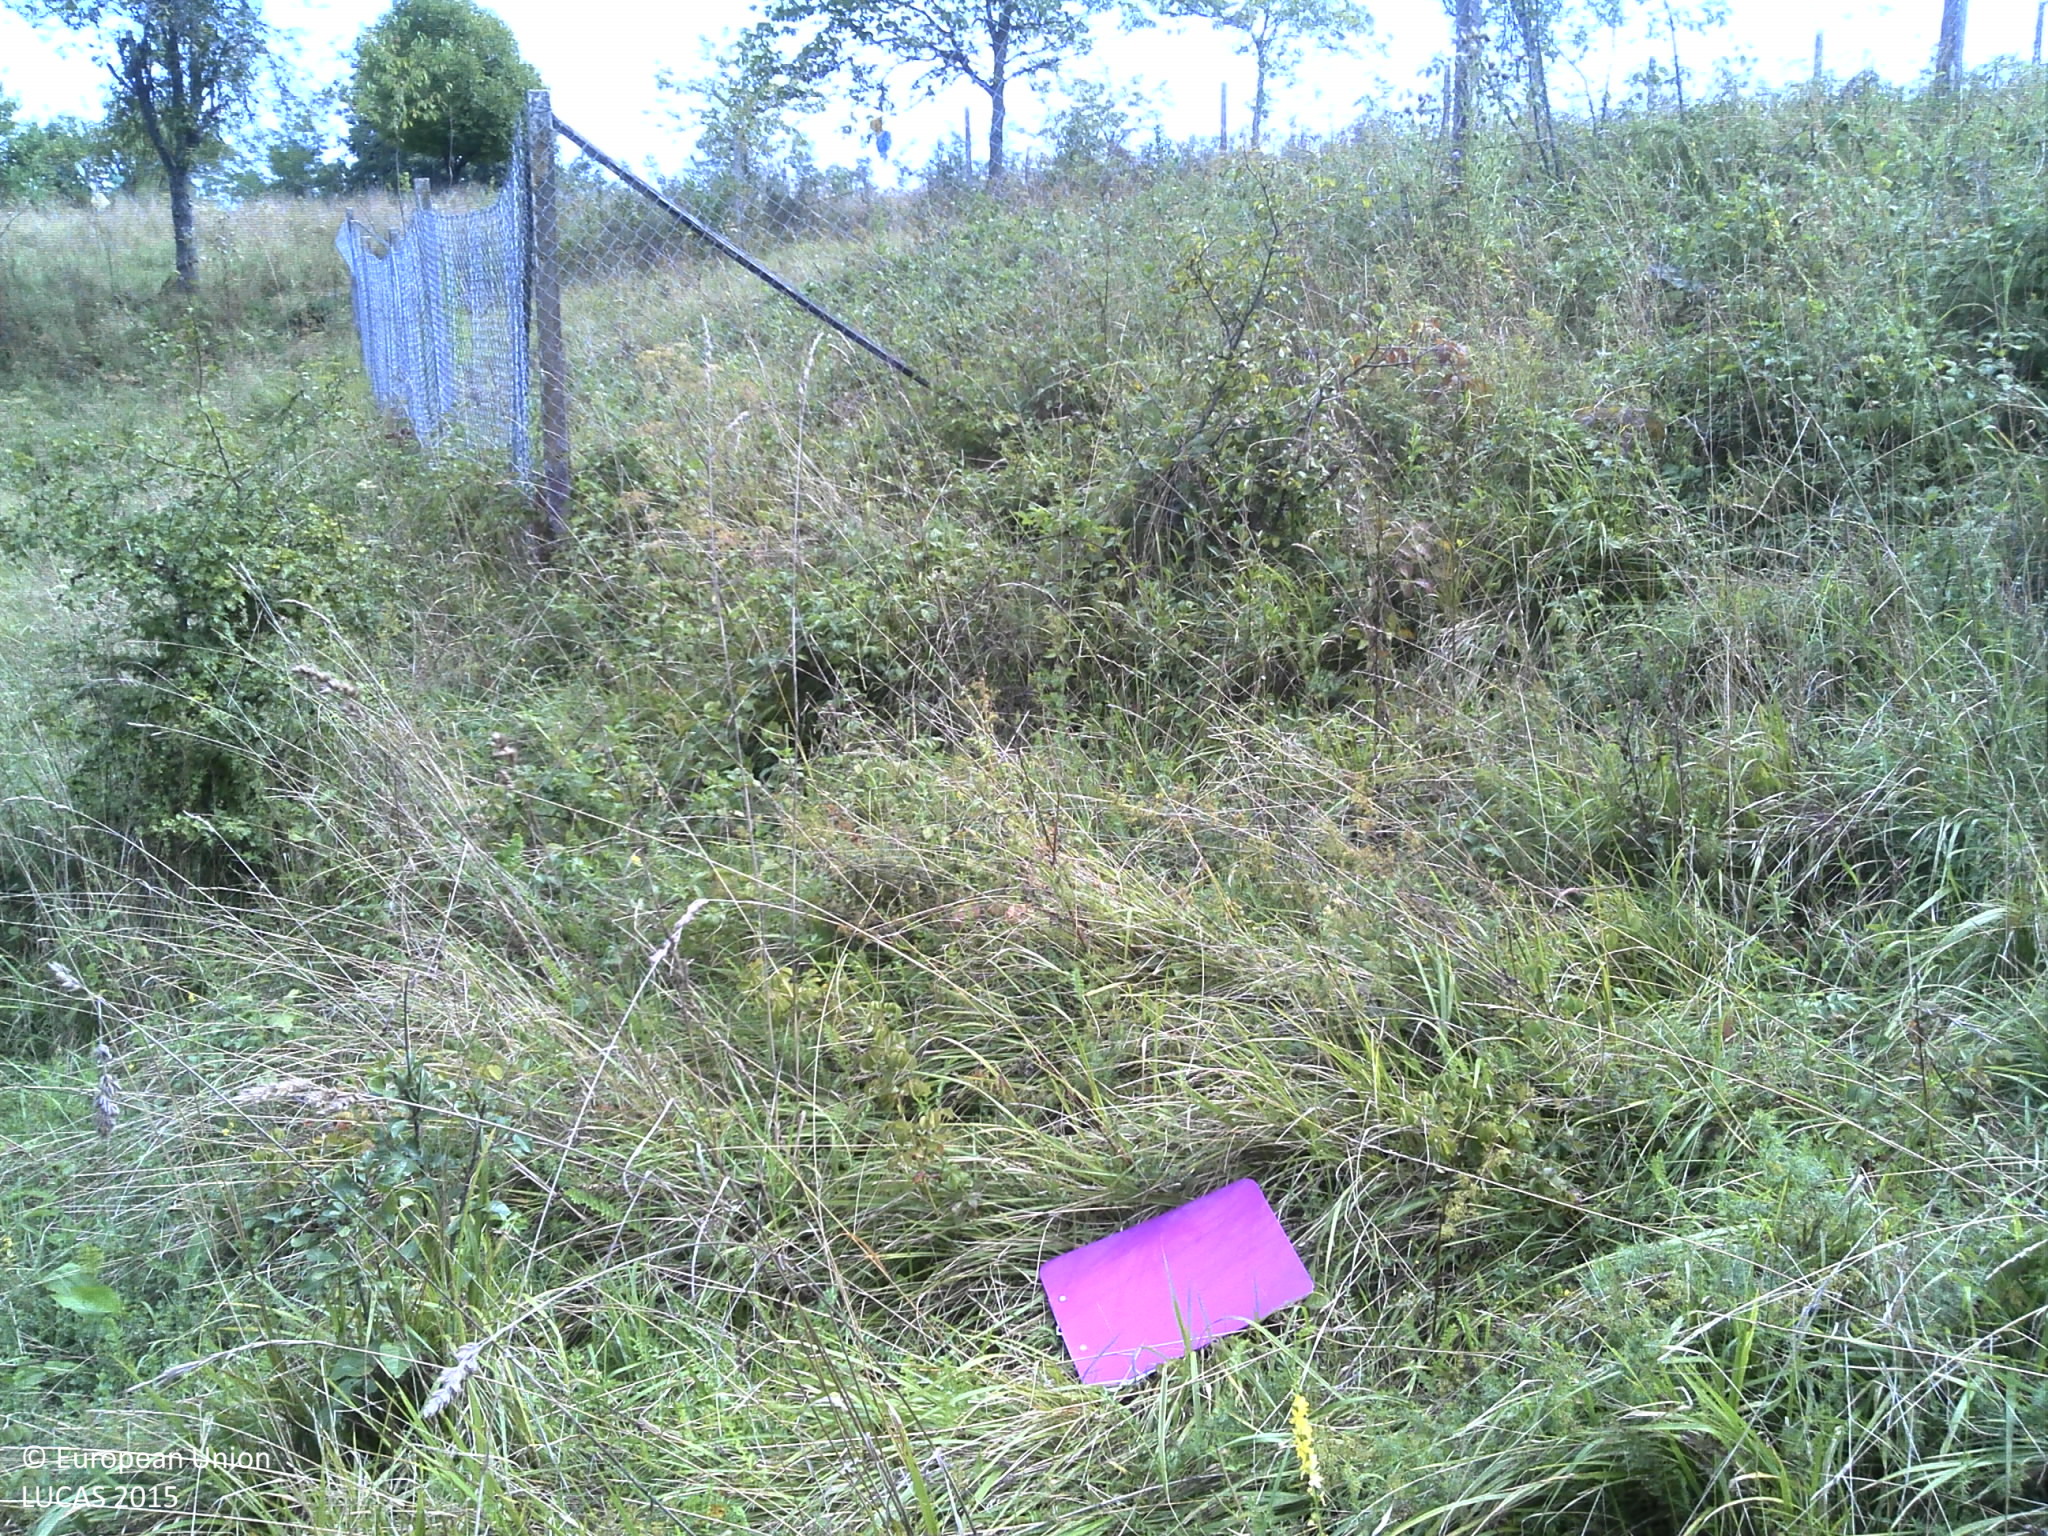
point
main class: Cropland
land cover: Lucerne
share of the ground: > 75 %
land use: Agriculture (excluding fallow land and kitchen gardens)
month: September
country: HR
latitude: 45.4460
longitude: 15.2506
